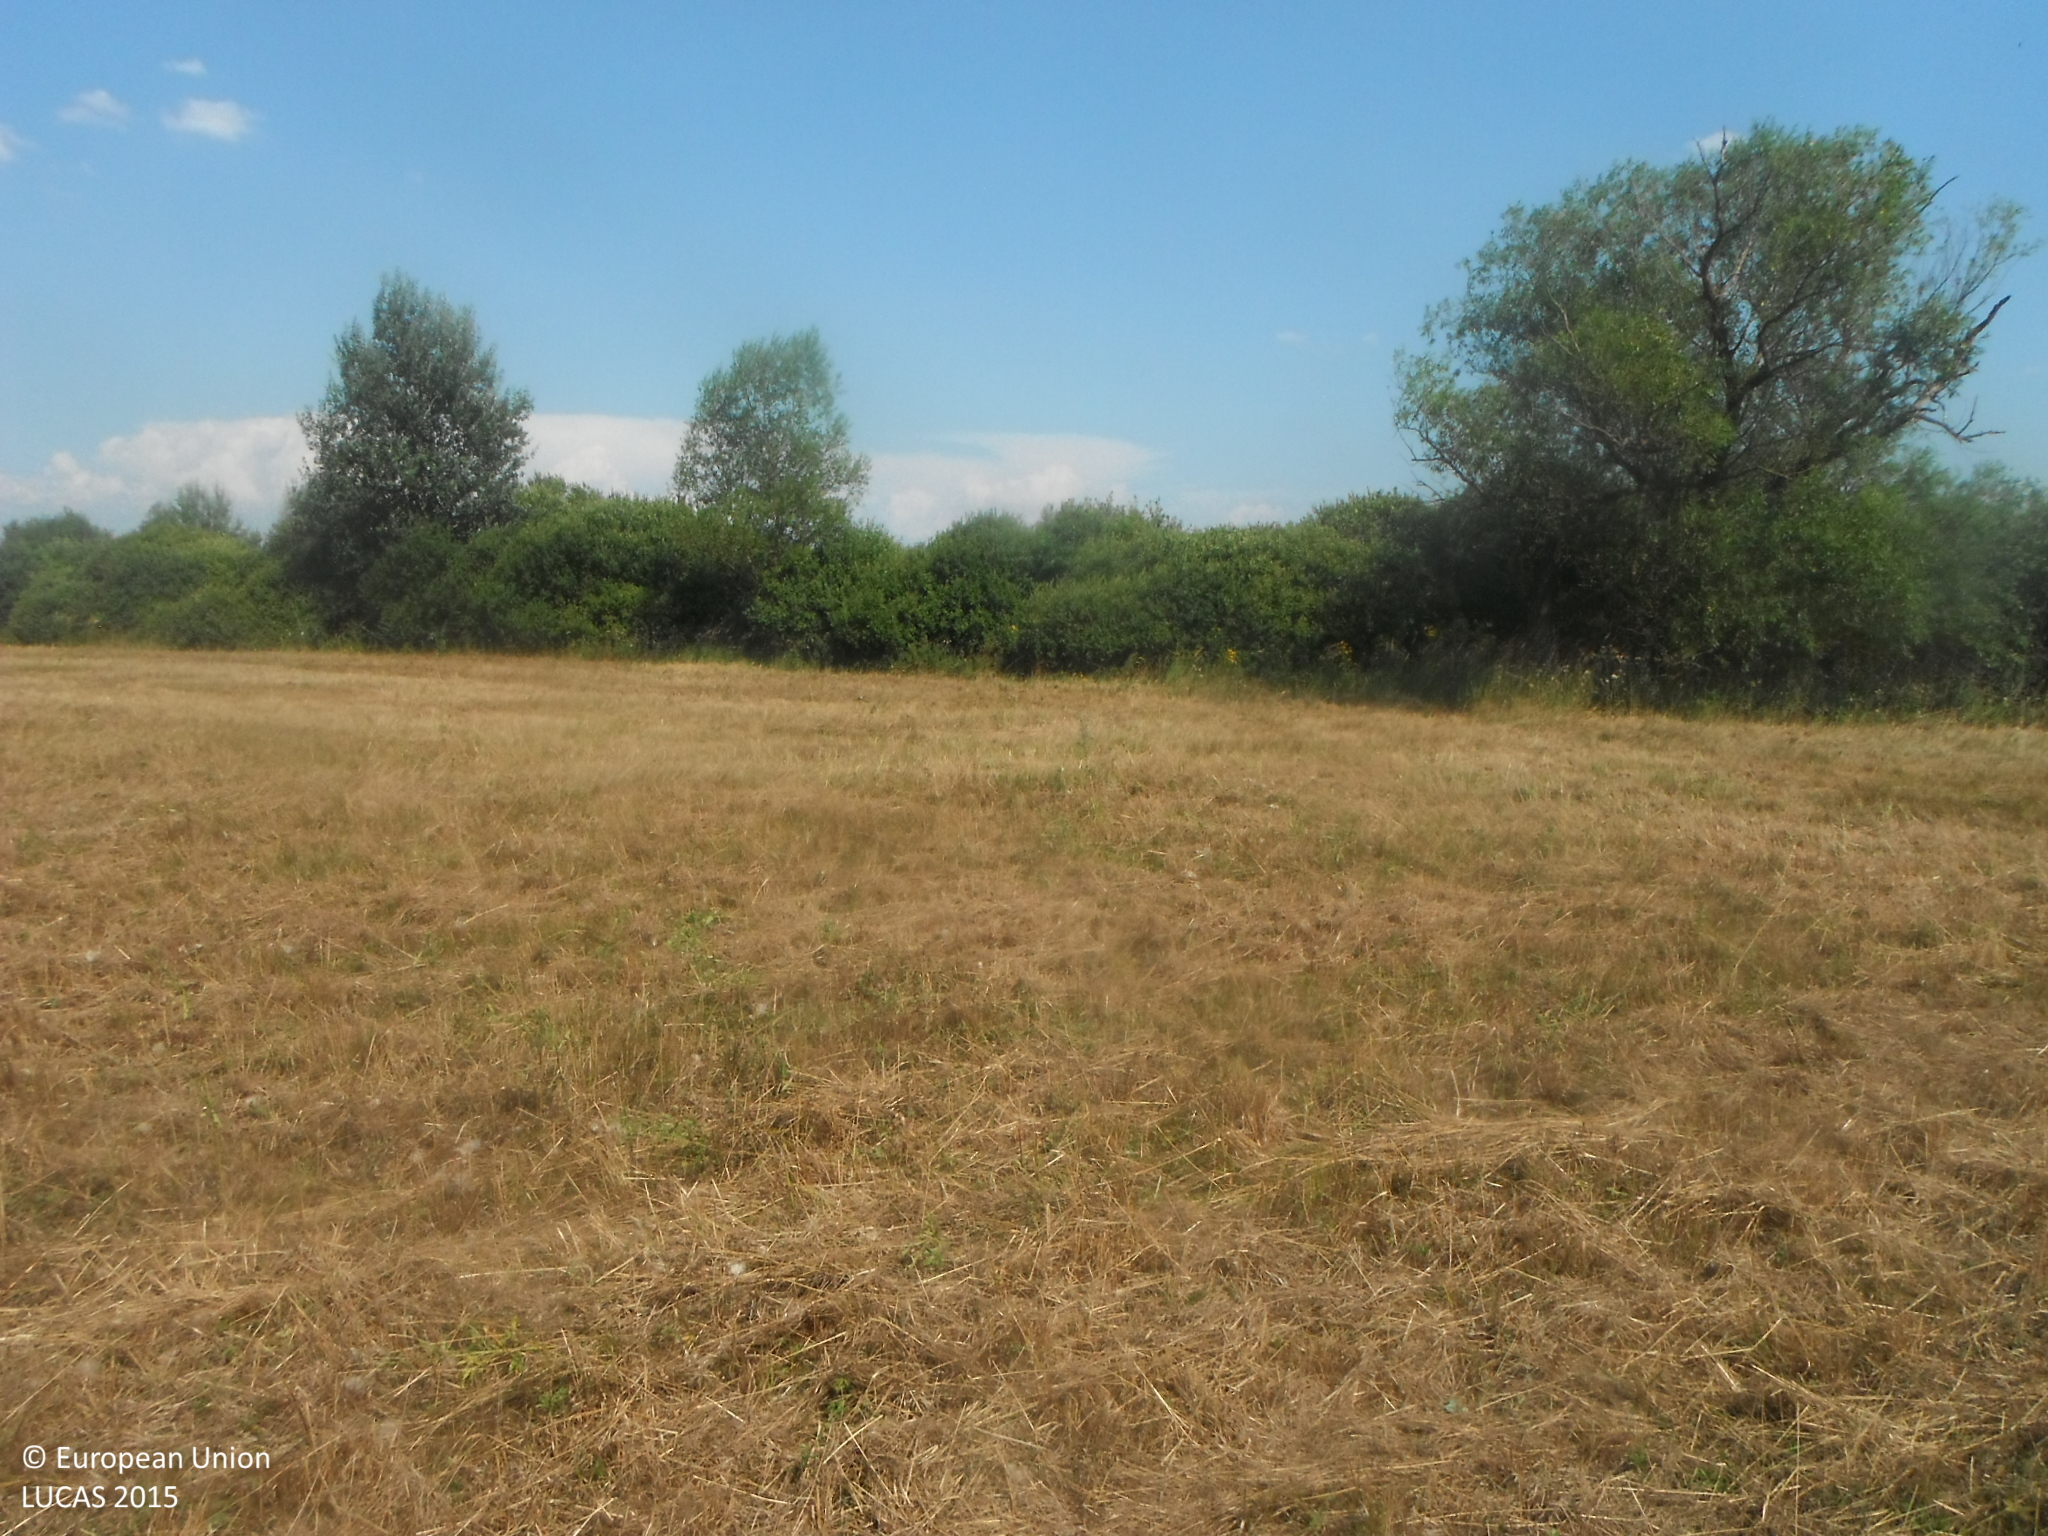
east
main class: Grassland
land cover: Grassland without tree/shrub cover
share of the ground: > 75 %
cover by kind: herbaceous plants 100 %
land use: Agriculture (excluding fallow land and kitchen gardens)
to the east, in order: Grassland without tree/shrub cover; Shrubland with sparse tree cover
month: August
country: SK
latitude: 48.5484
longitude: 21.8237
